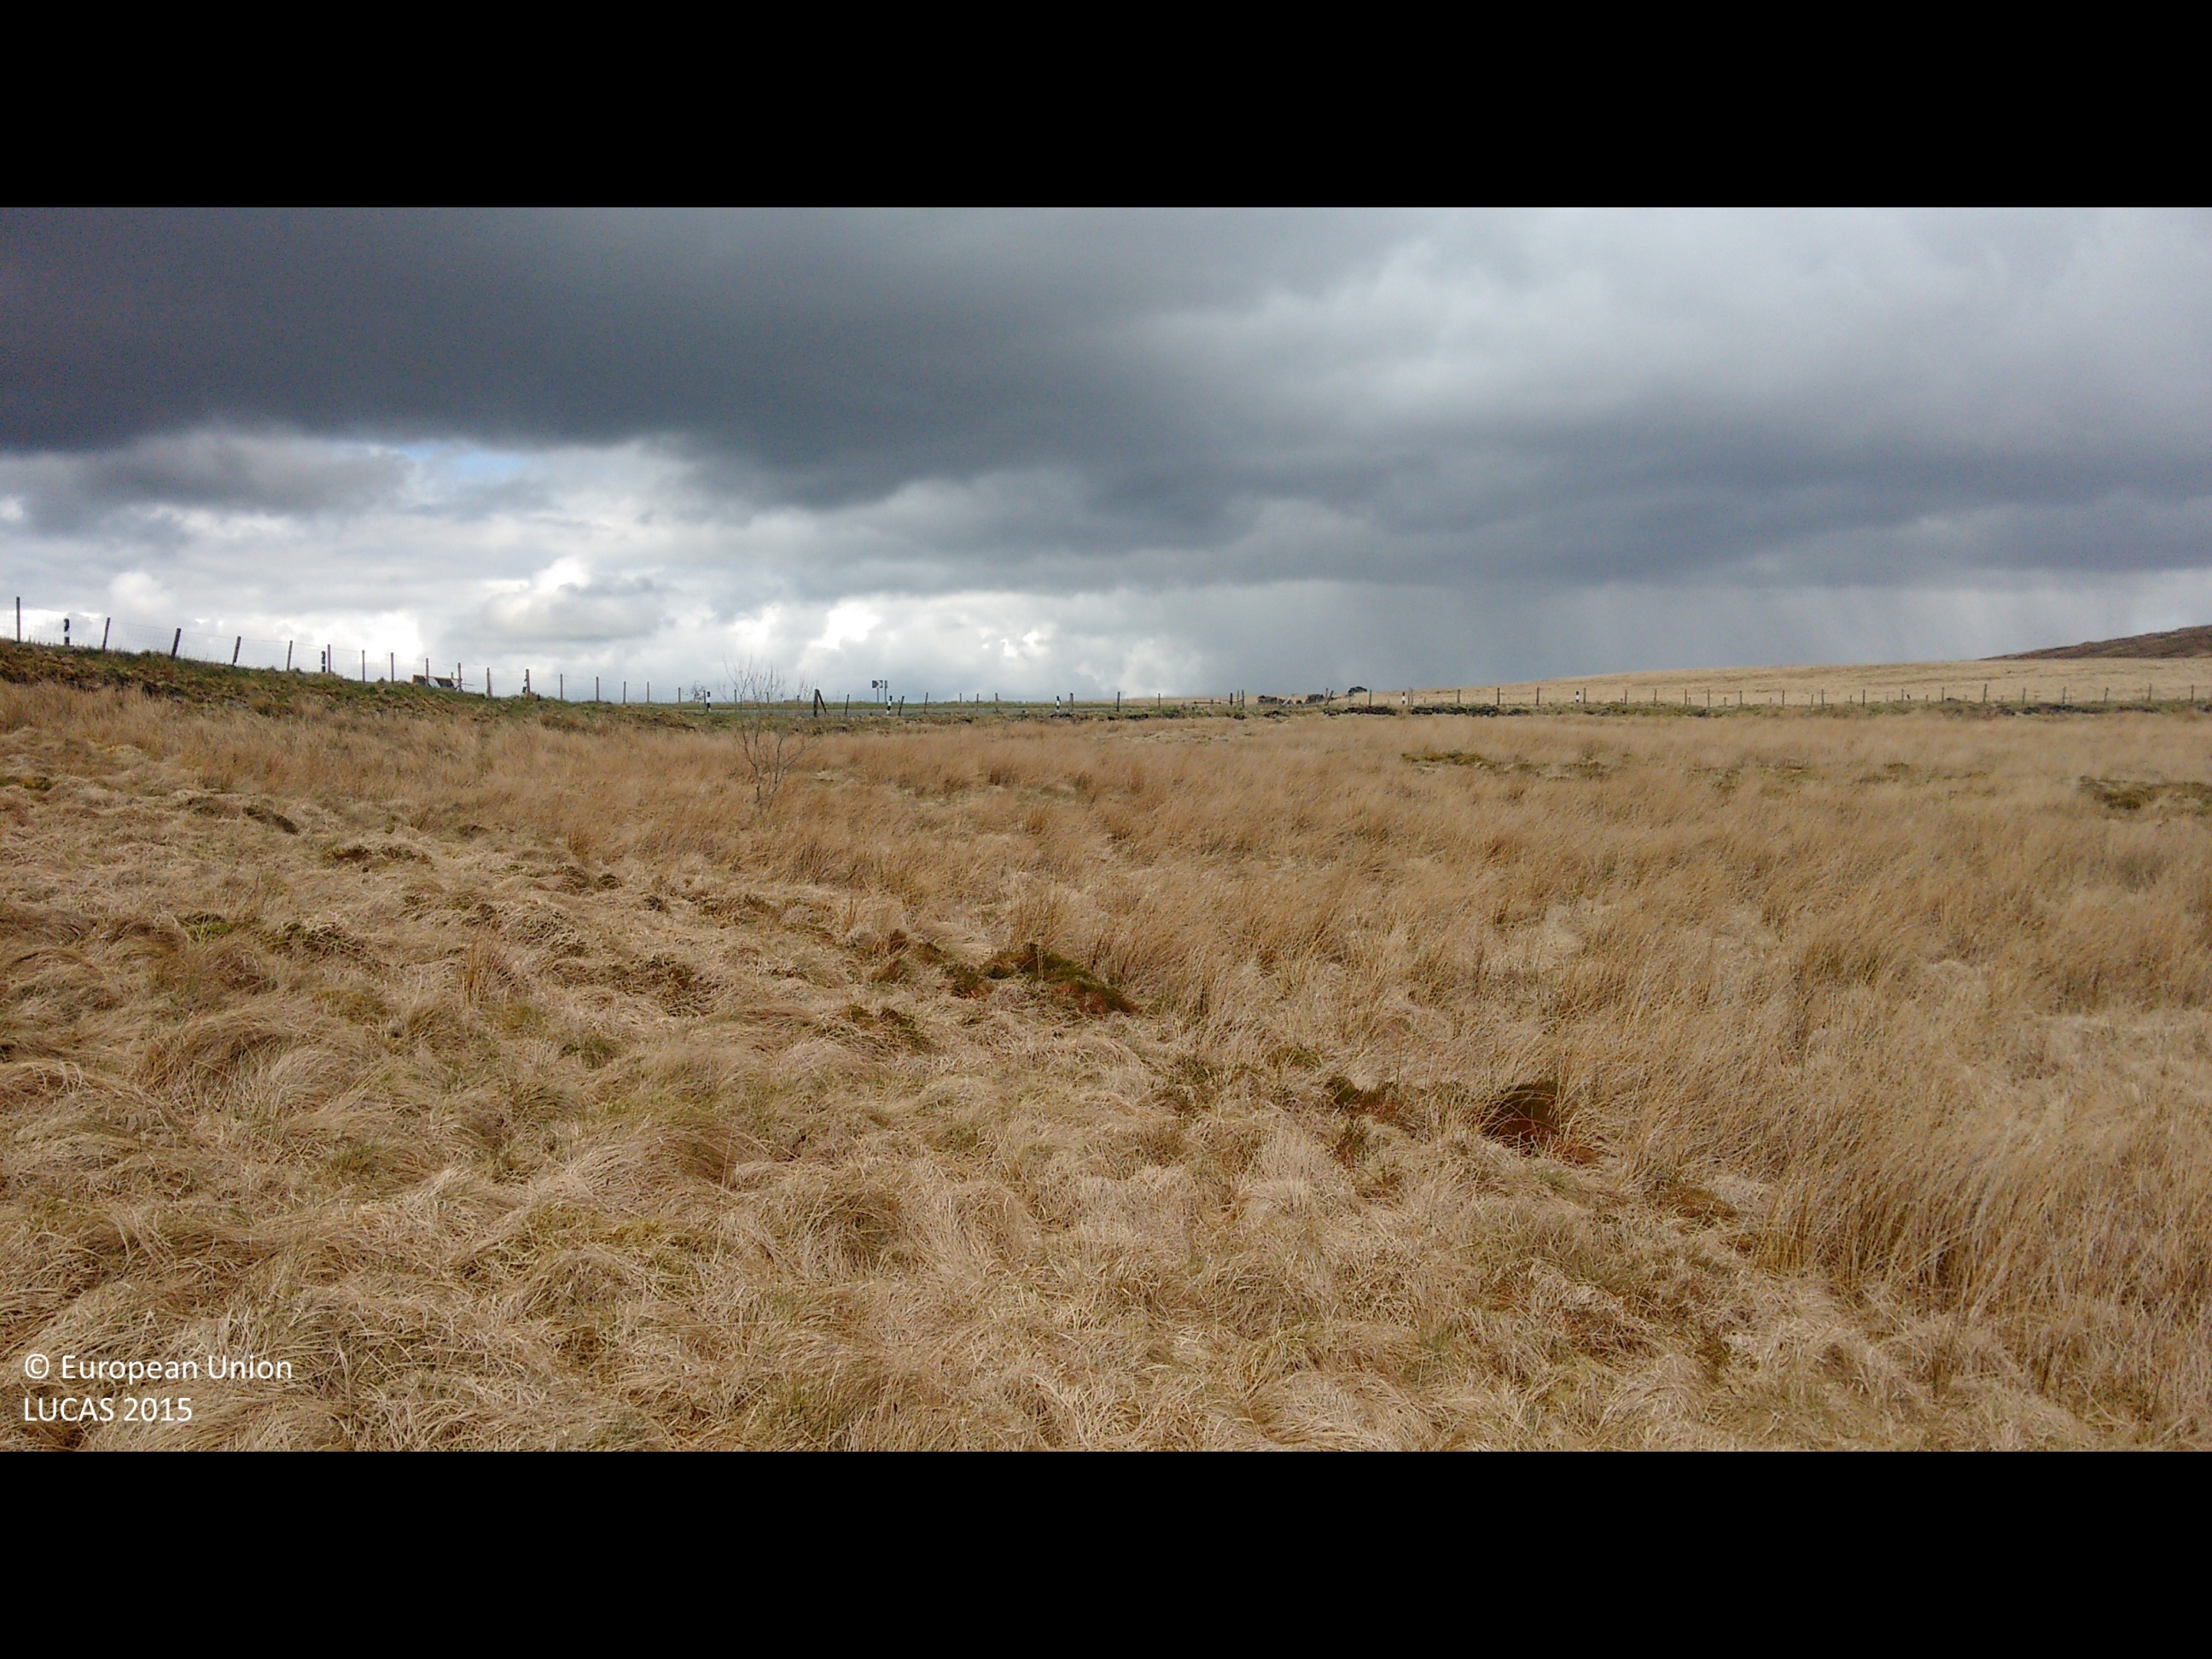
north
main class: Grassland
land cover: Grassland without tree/shrub cover
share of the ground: > 75 %
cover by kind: herbaceous plants 100 %
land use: Agriculture (excluding fallow land and kitchen gardens)
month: April
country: GB
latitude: 53.7519
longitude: -2.1463
